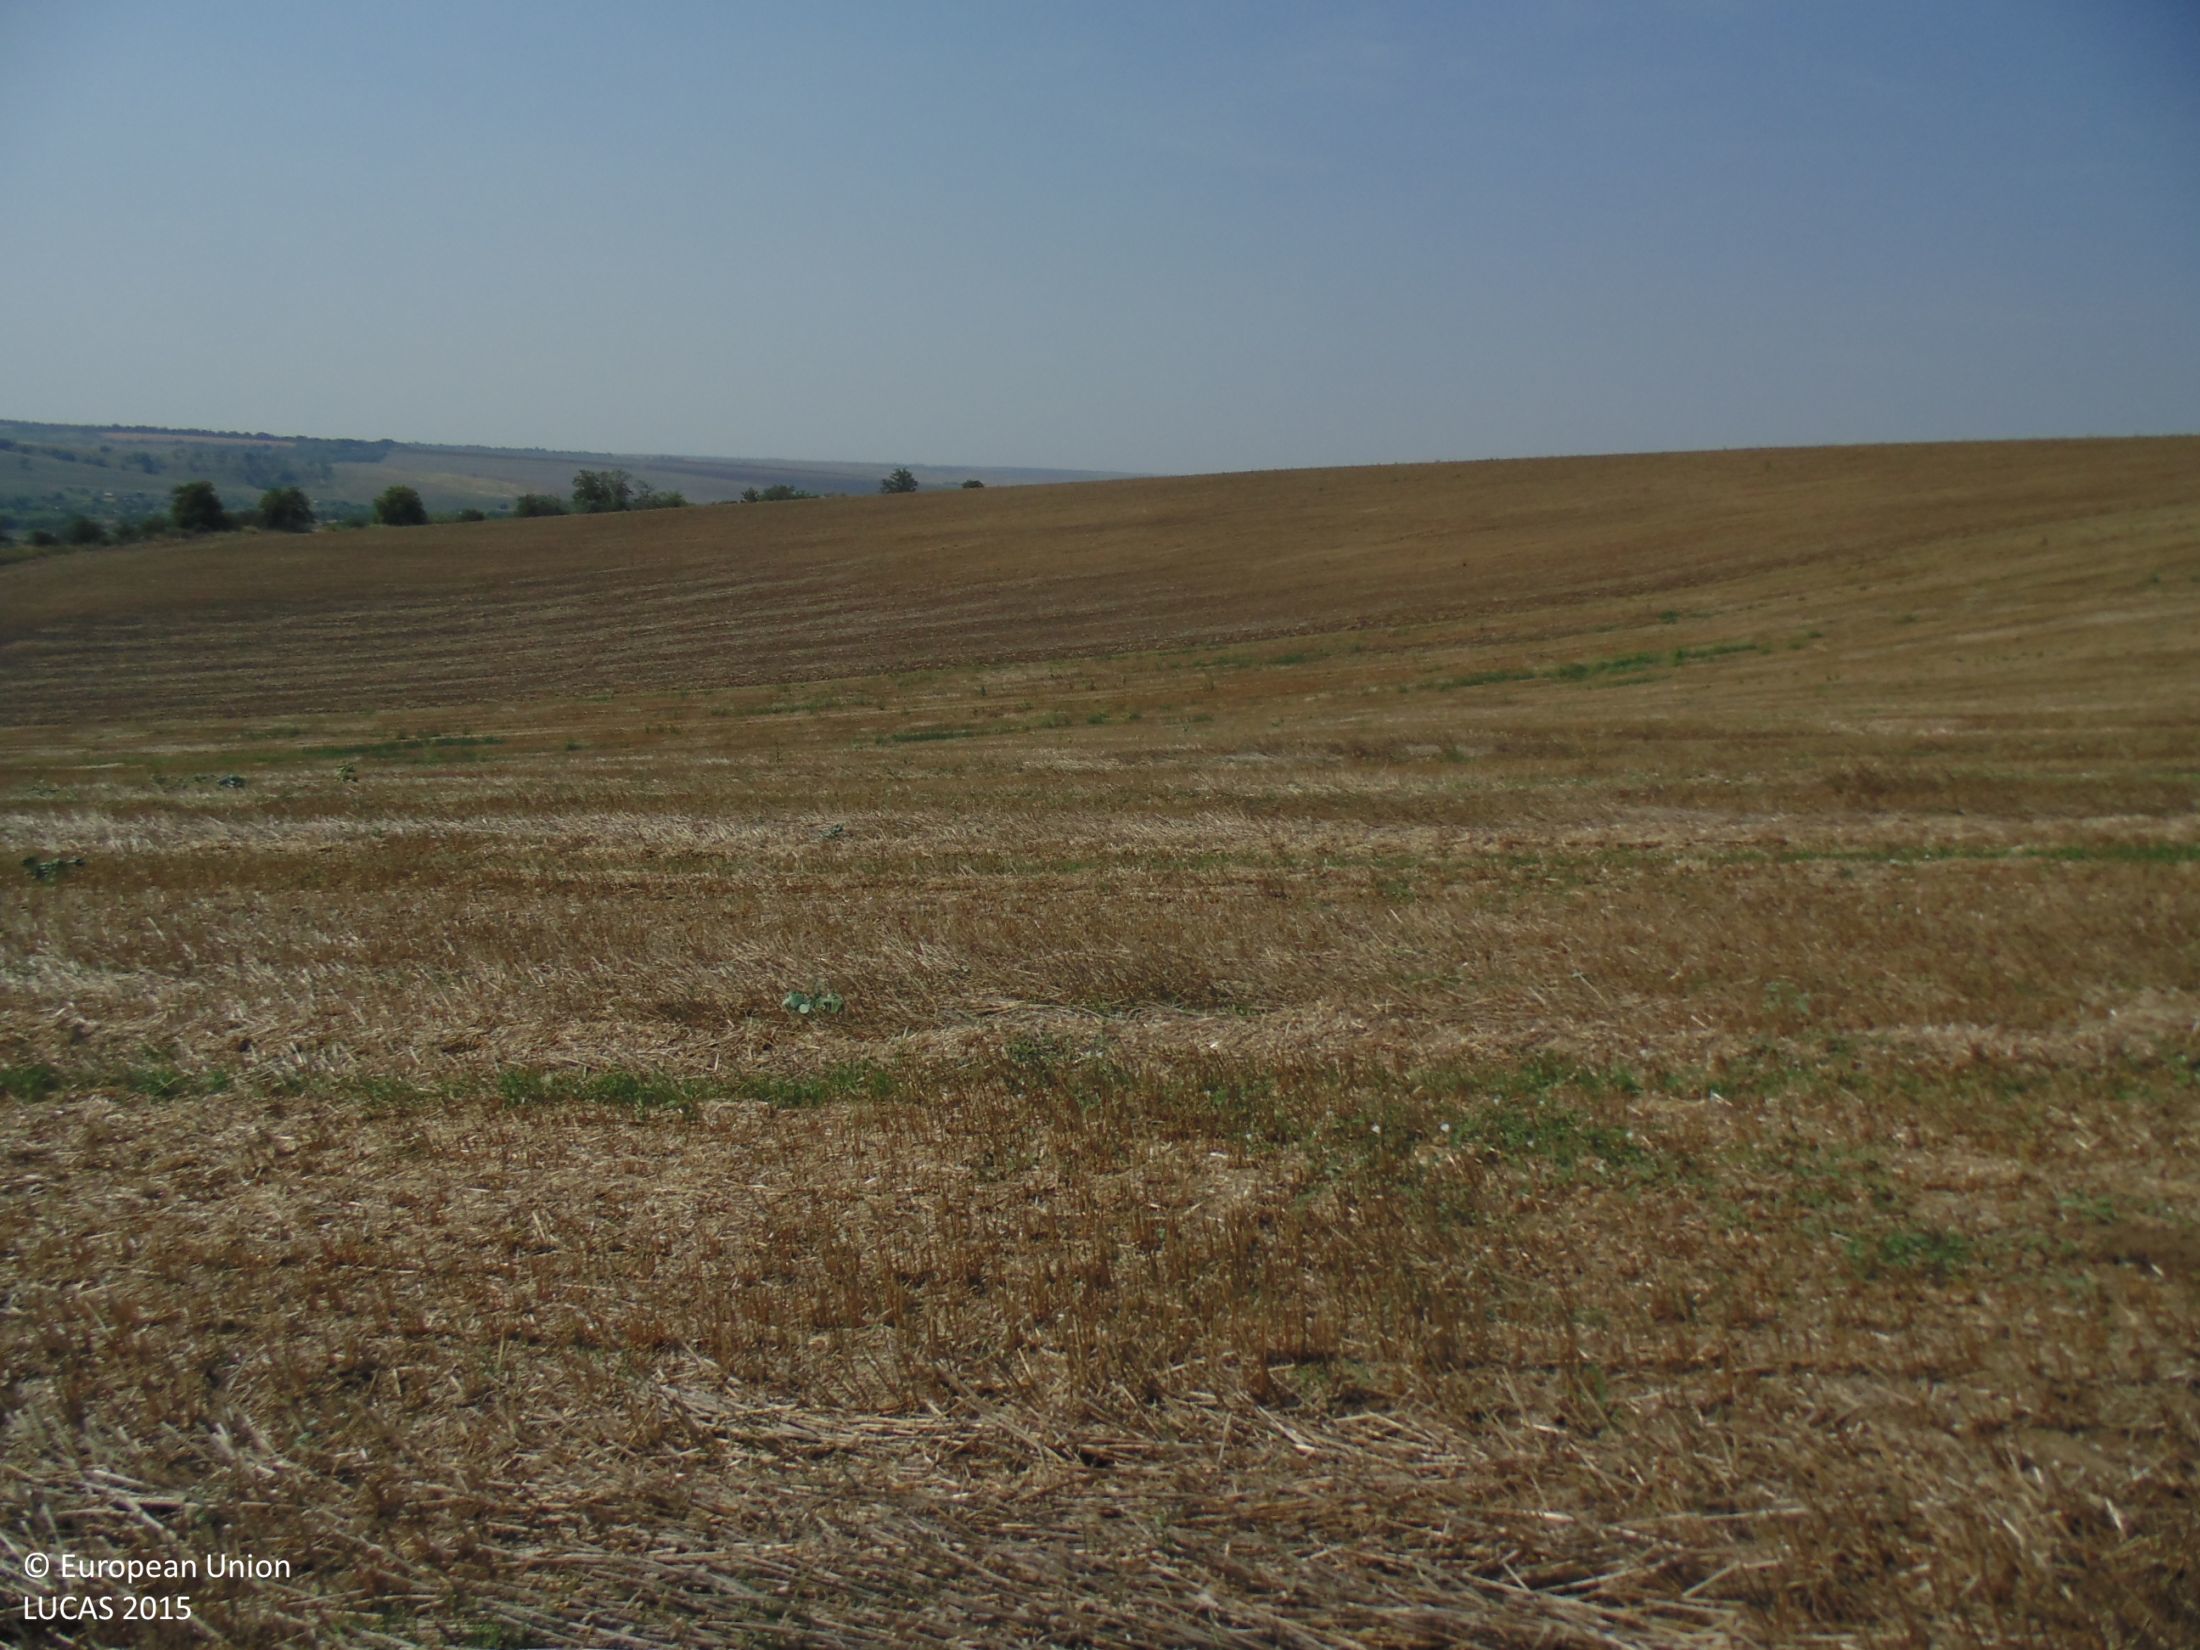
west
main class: Cropland
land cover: Common wheat
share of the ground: 10 - 25 %
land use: Agriculture (excluding fallow land and kitchen gardens)
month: August
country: BG
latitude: 44.0145
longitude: 27.2571
